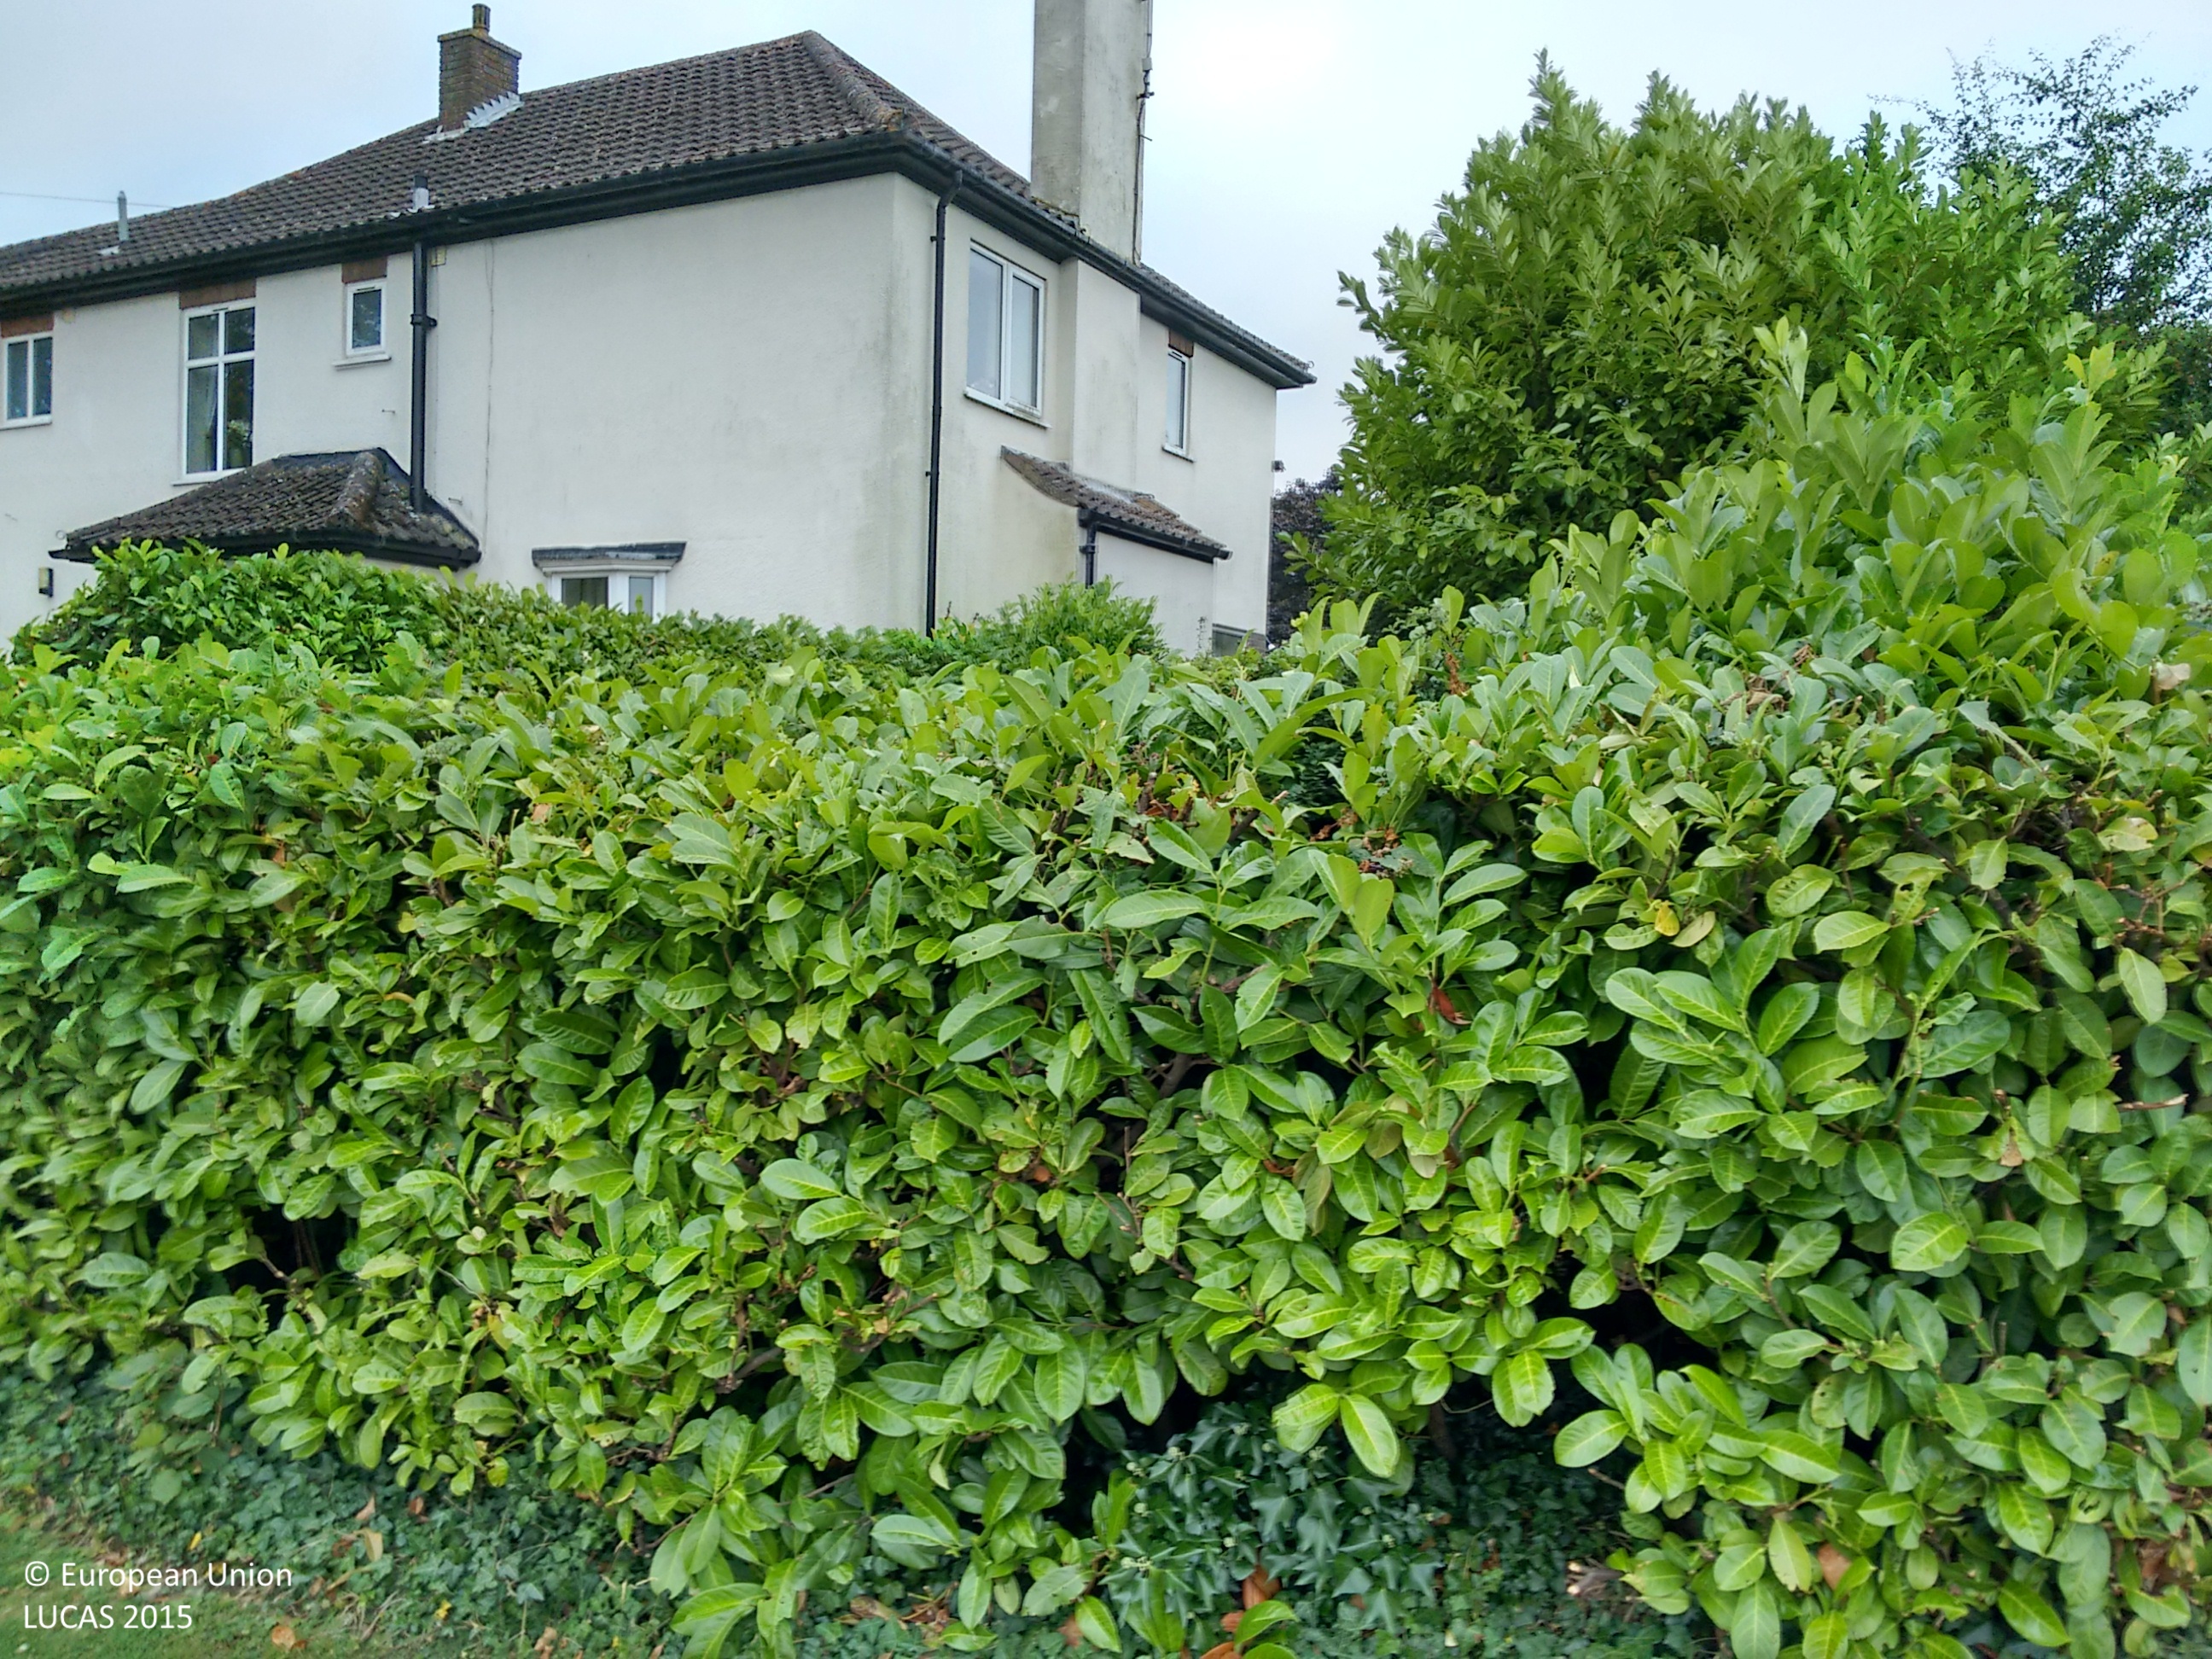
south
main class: Grassland
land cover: Grassland without tree/shrub cover
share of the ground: > 75 %
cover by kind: herbaceous plants 100 %
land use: Sport
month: August
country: GB
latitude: 52.3093
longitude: -0.7037
